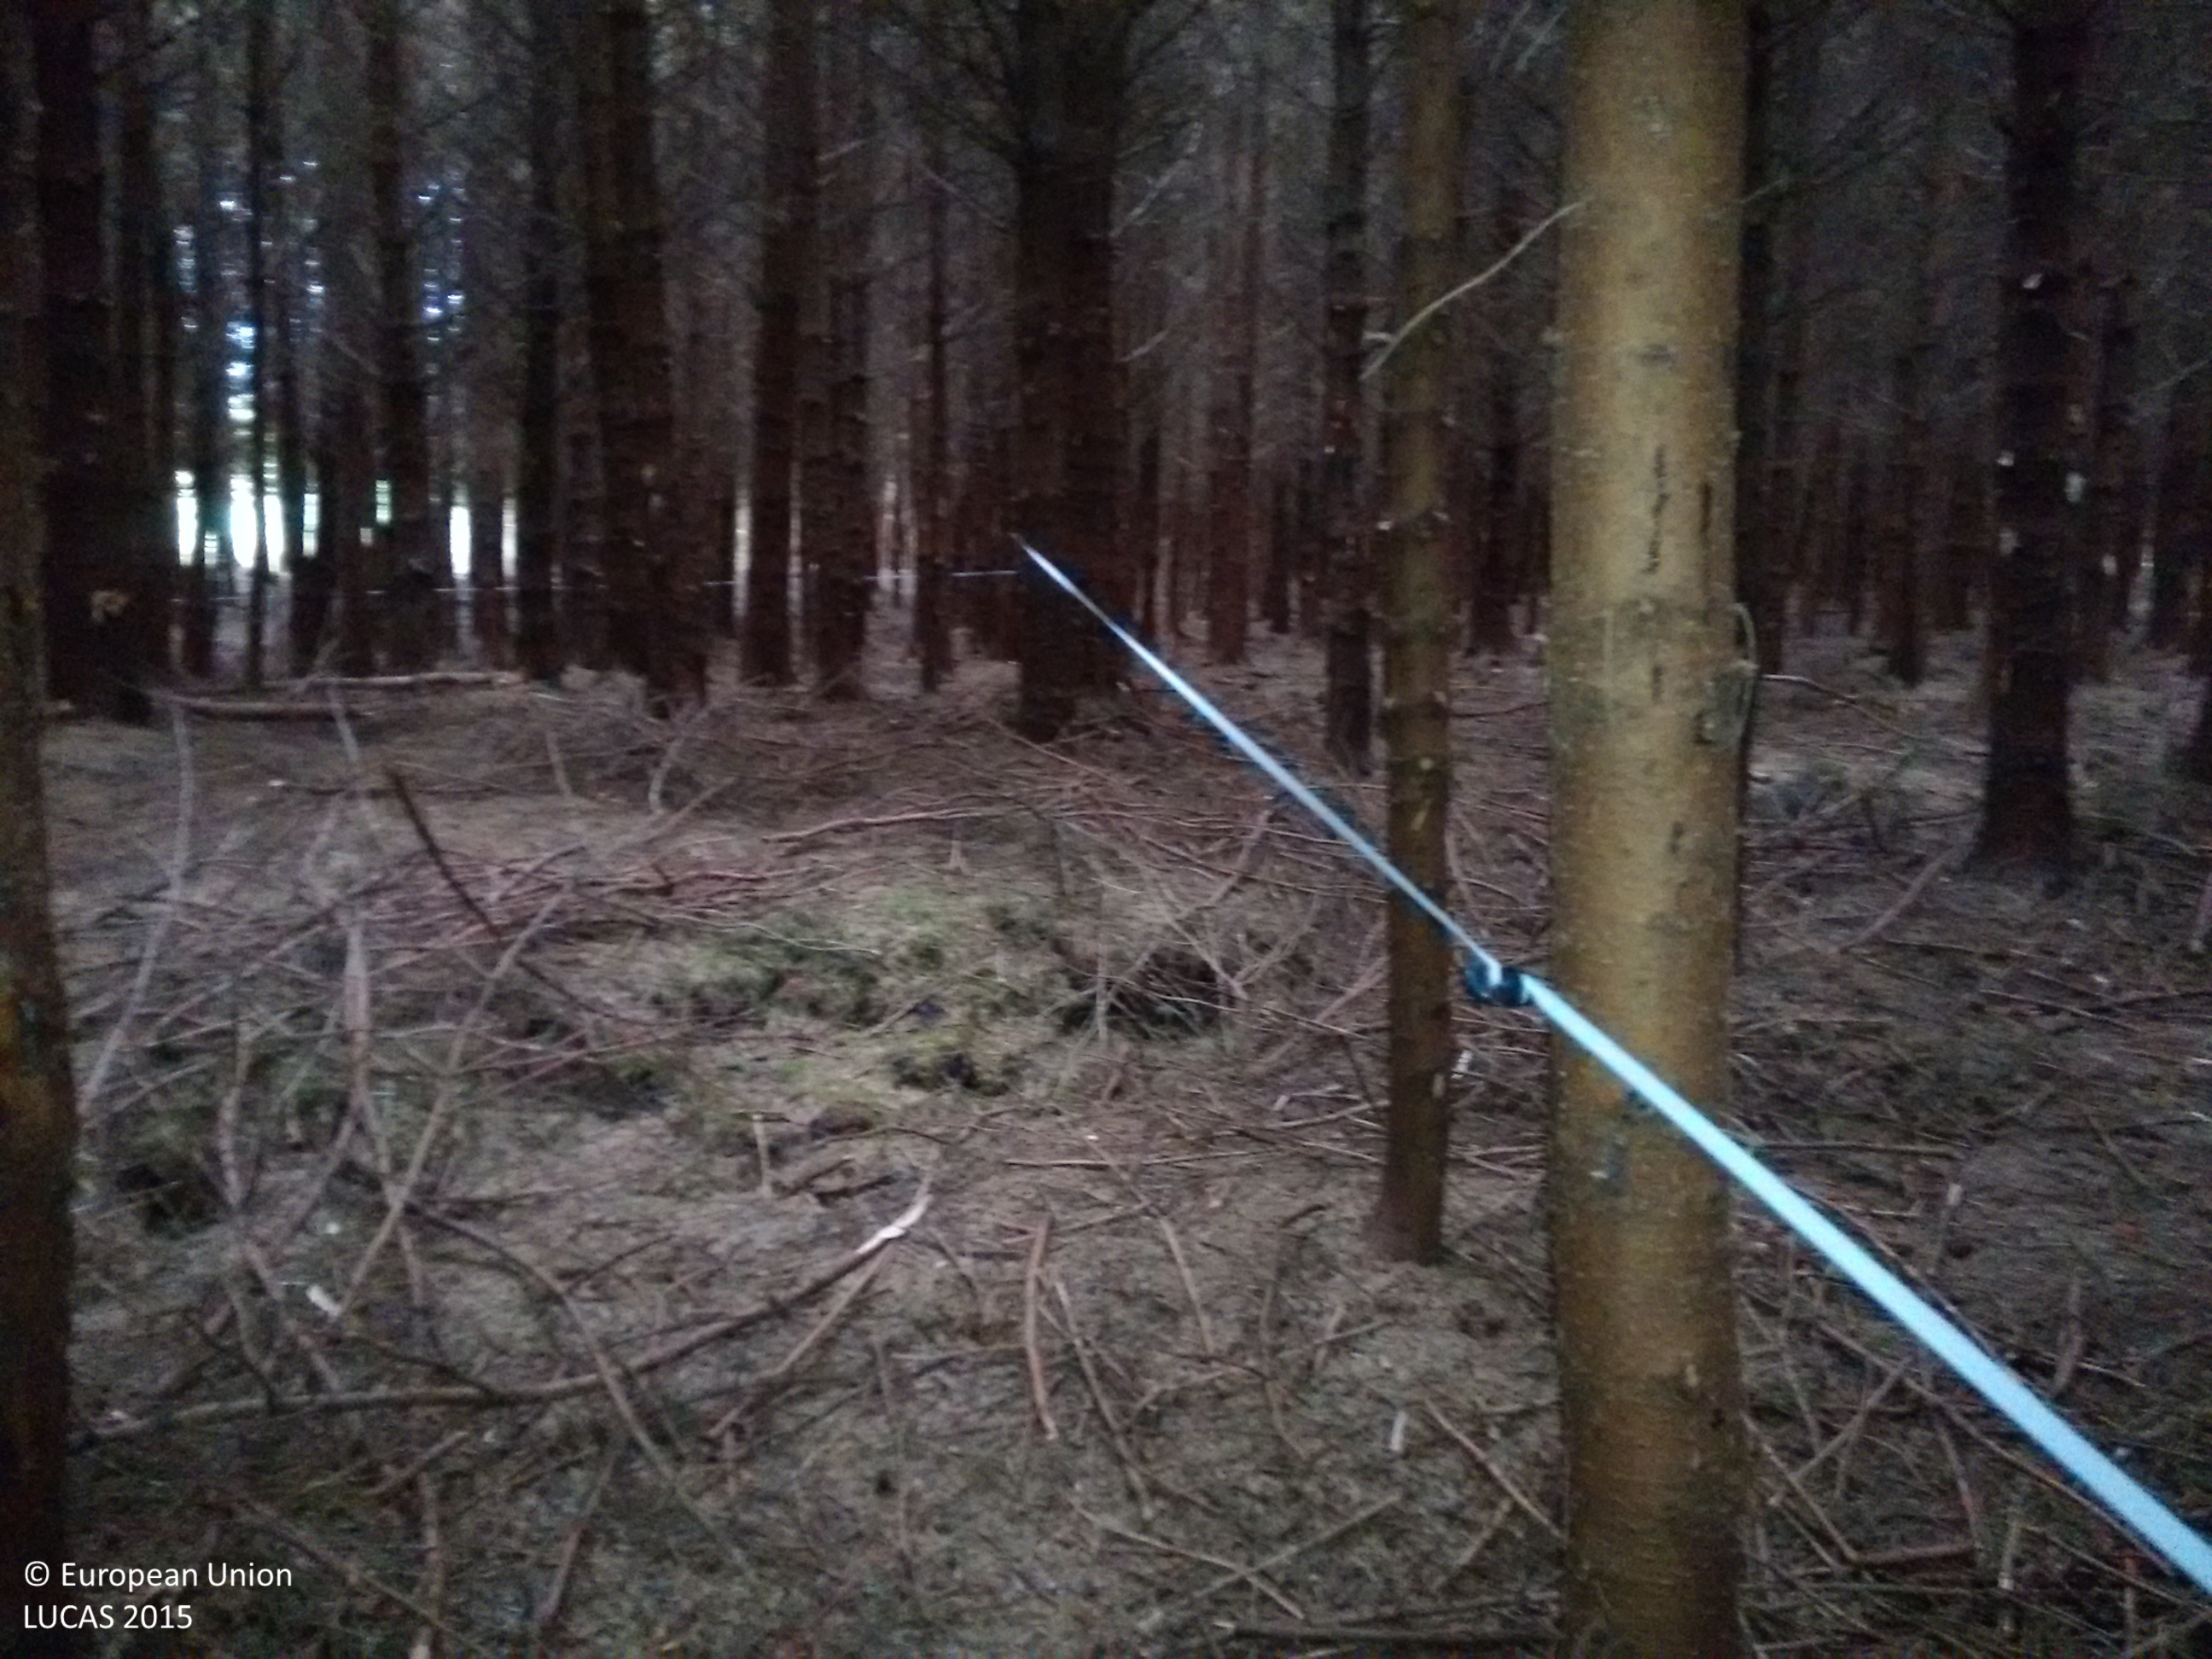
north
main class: Woodland
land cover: Spruce dominated coniferous woodland
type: exotic forest
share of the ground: > 75 %
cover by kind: coniferous forest trees 100 %
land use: Forestry
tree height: > 5 m
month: September
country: IE
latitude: 52.9969
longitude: -9.2805
